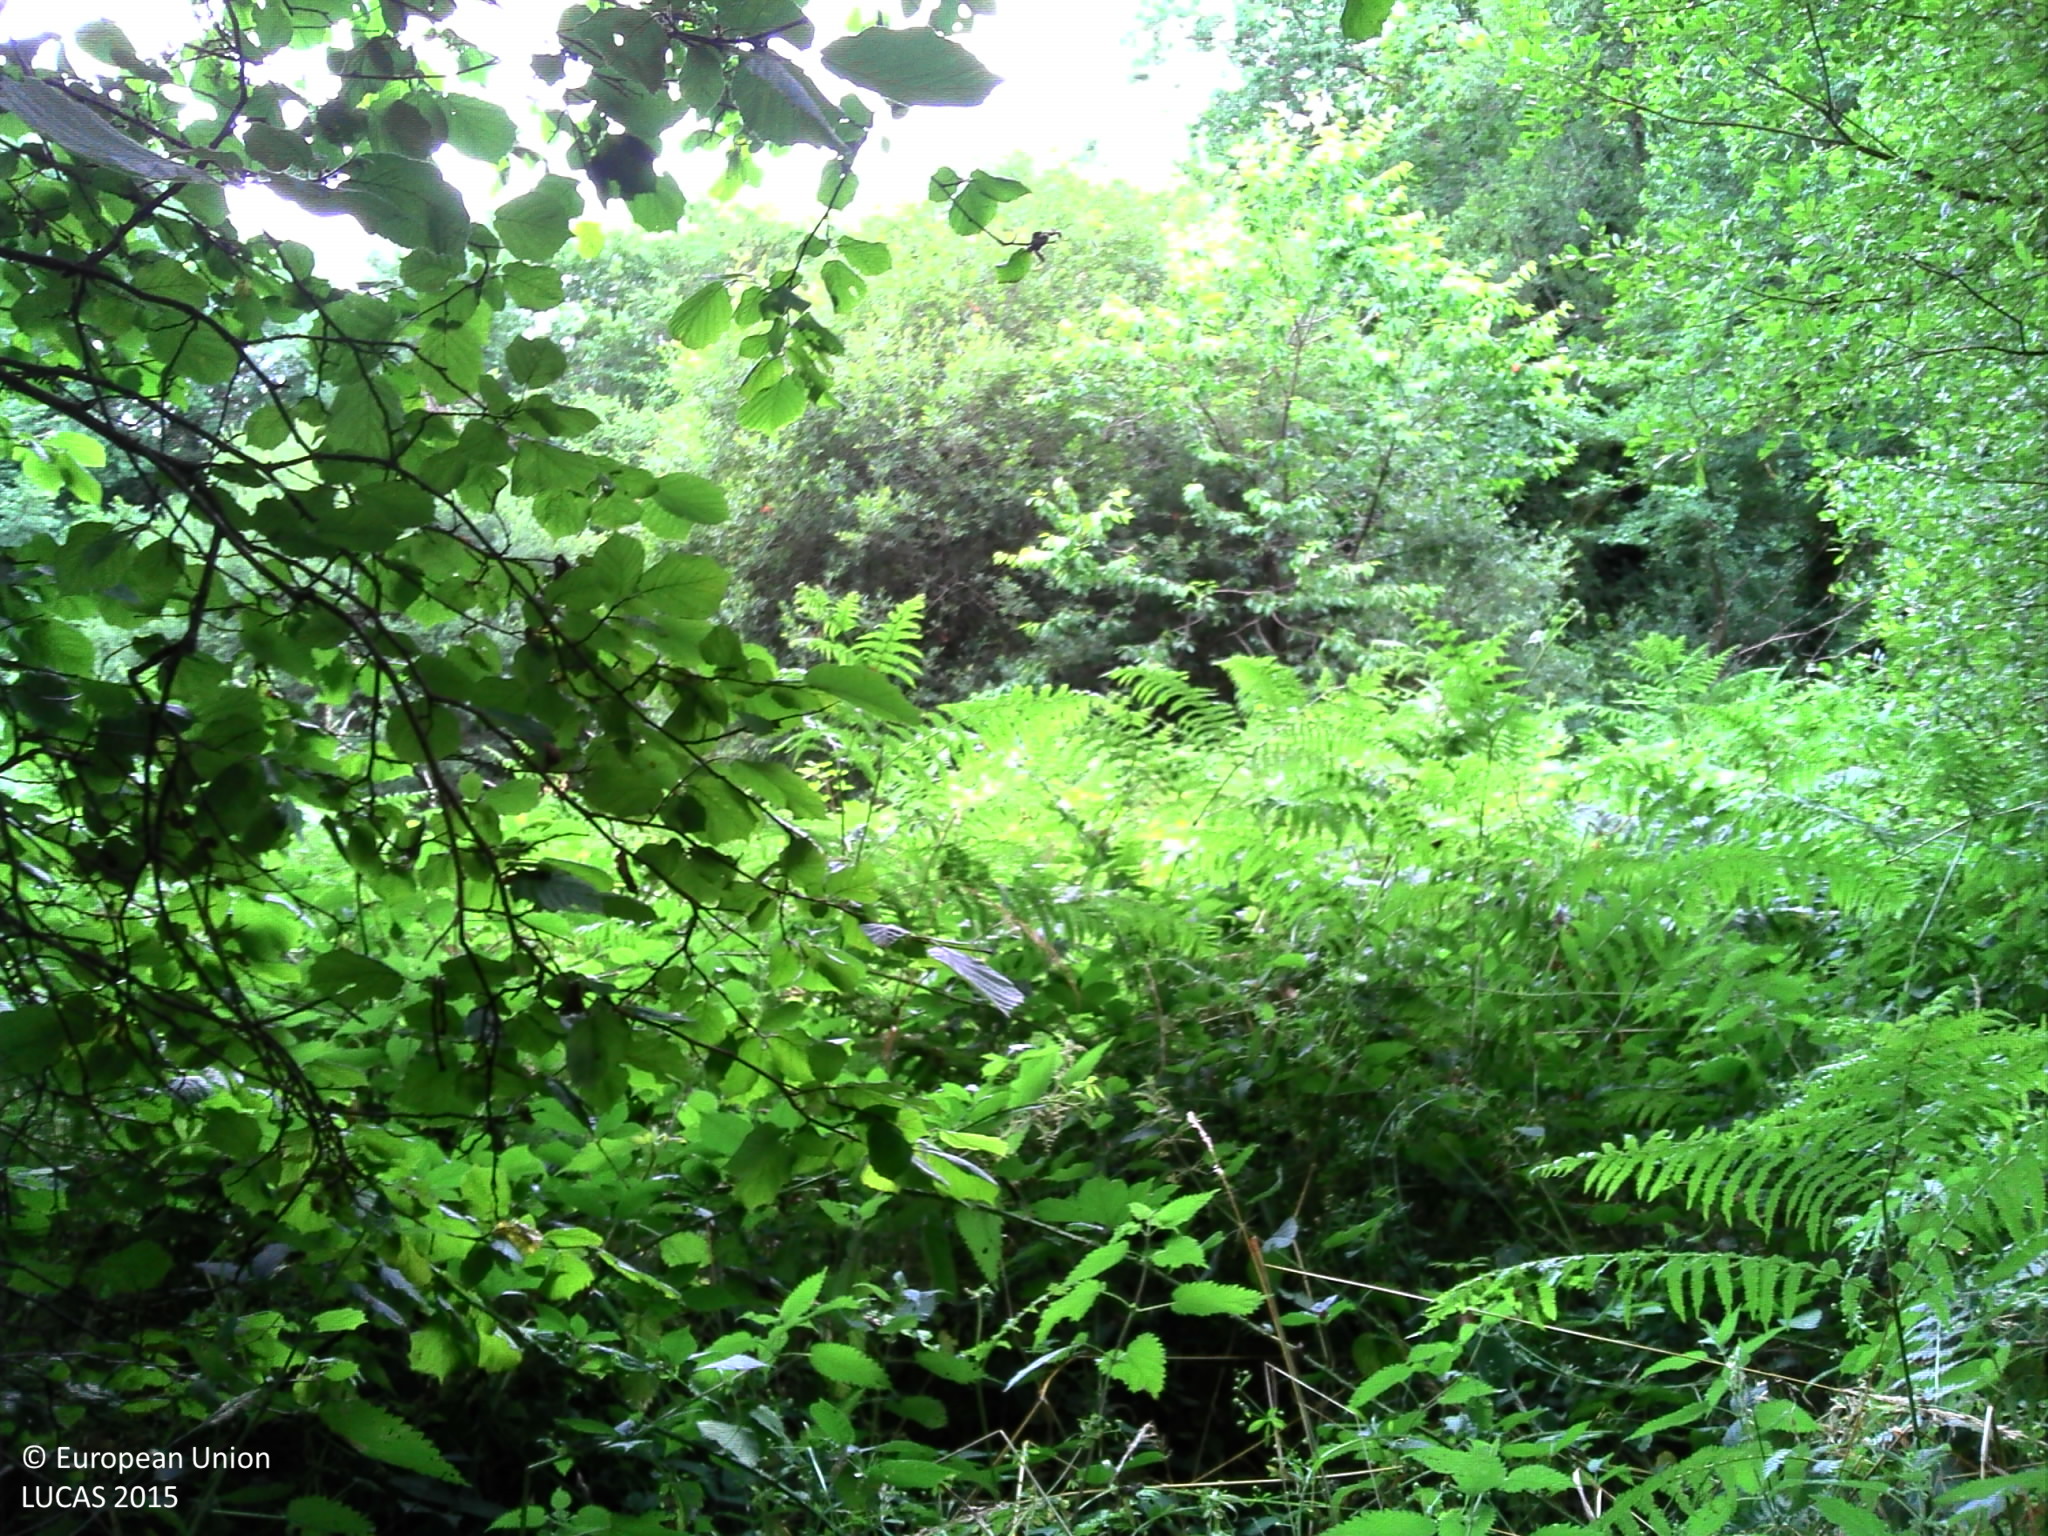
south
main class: Woodland
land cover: Broadleaved woodland
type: mesophytic deciduous forest
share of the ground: > 75 %
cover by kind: broadleaved forest trees 65 %, herbaceous plants 20 %, consolidated bare surface 10 %, lichens and mosses 5 %
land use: Forestry
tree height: > 5 m
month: July
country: FR
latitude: 47.8731
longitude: -3.2678
